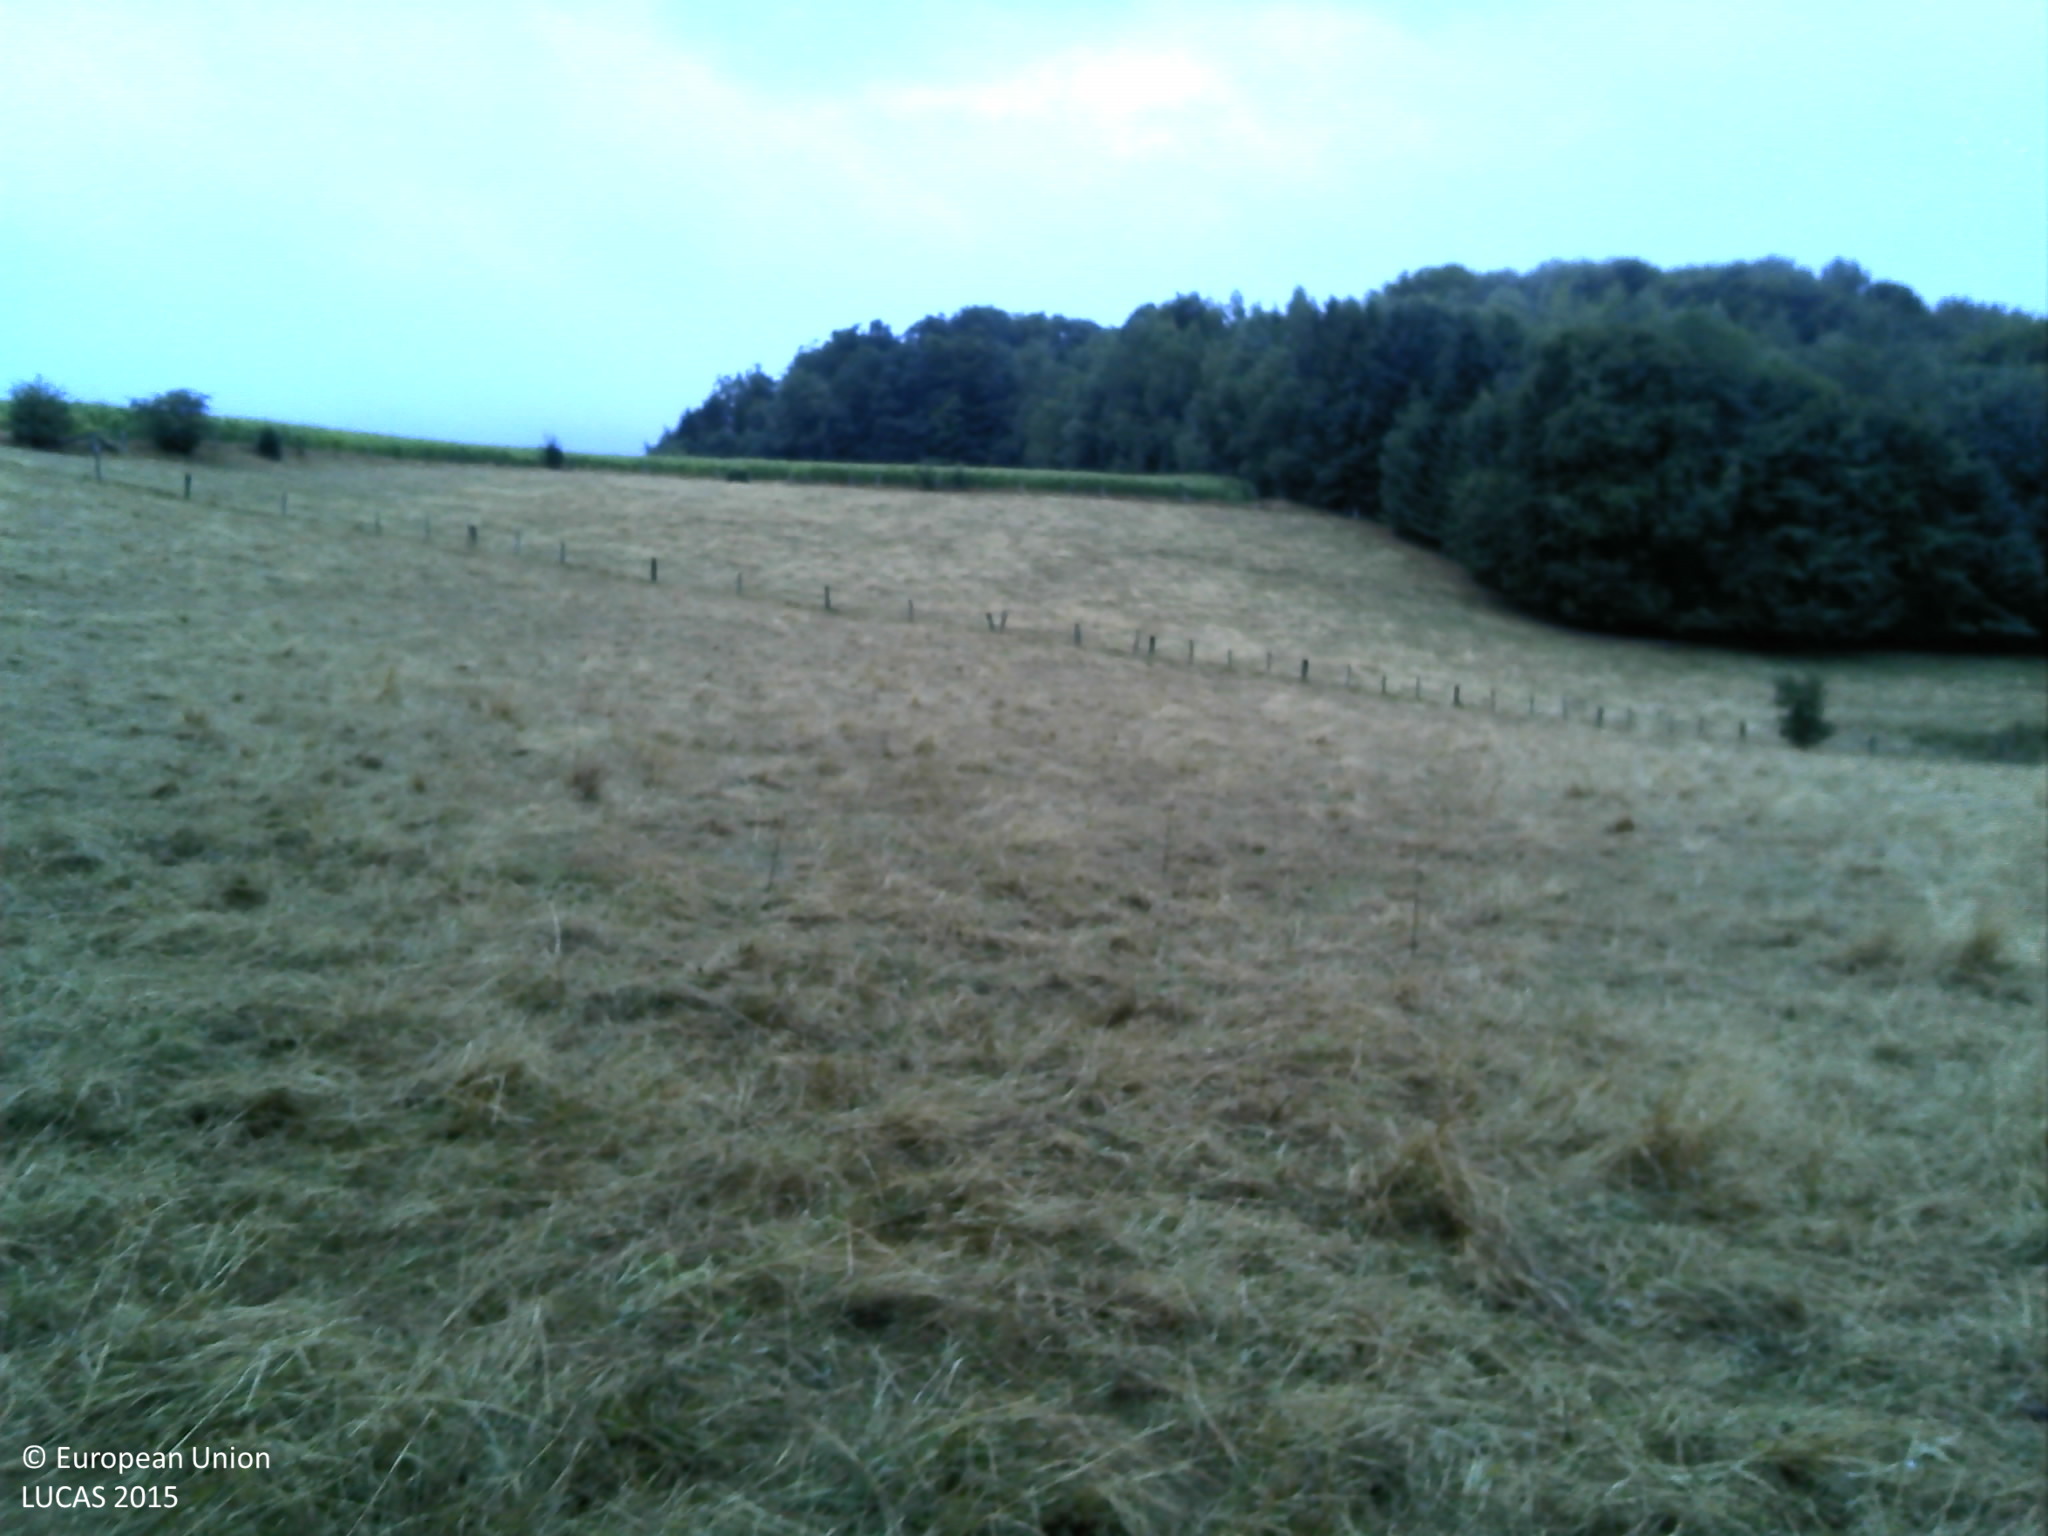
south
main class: Grassland
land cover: Grassland with sparse tree/shrub cover
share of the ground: > 75 %
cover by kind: herbaceous plants 95 %, broadleaved forest trees 5 %
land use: Agriculture (excluding fallow land and kitchen gardens)
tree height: > 5 m
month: July
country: FR
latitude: 47.9990
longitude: 6.2884
